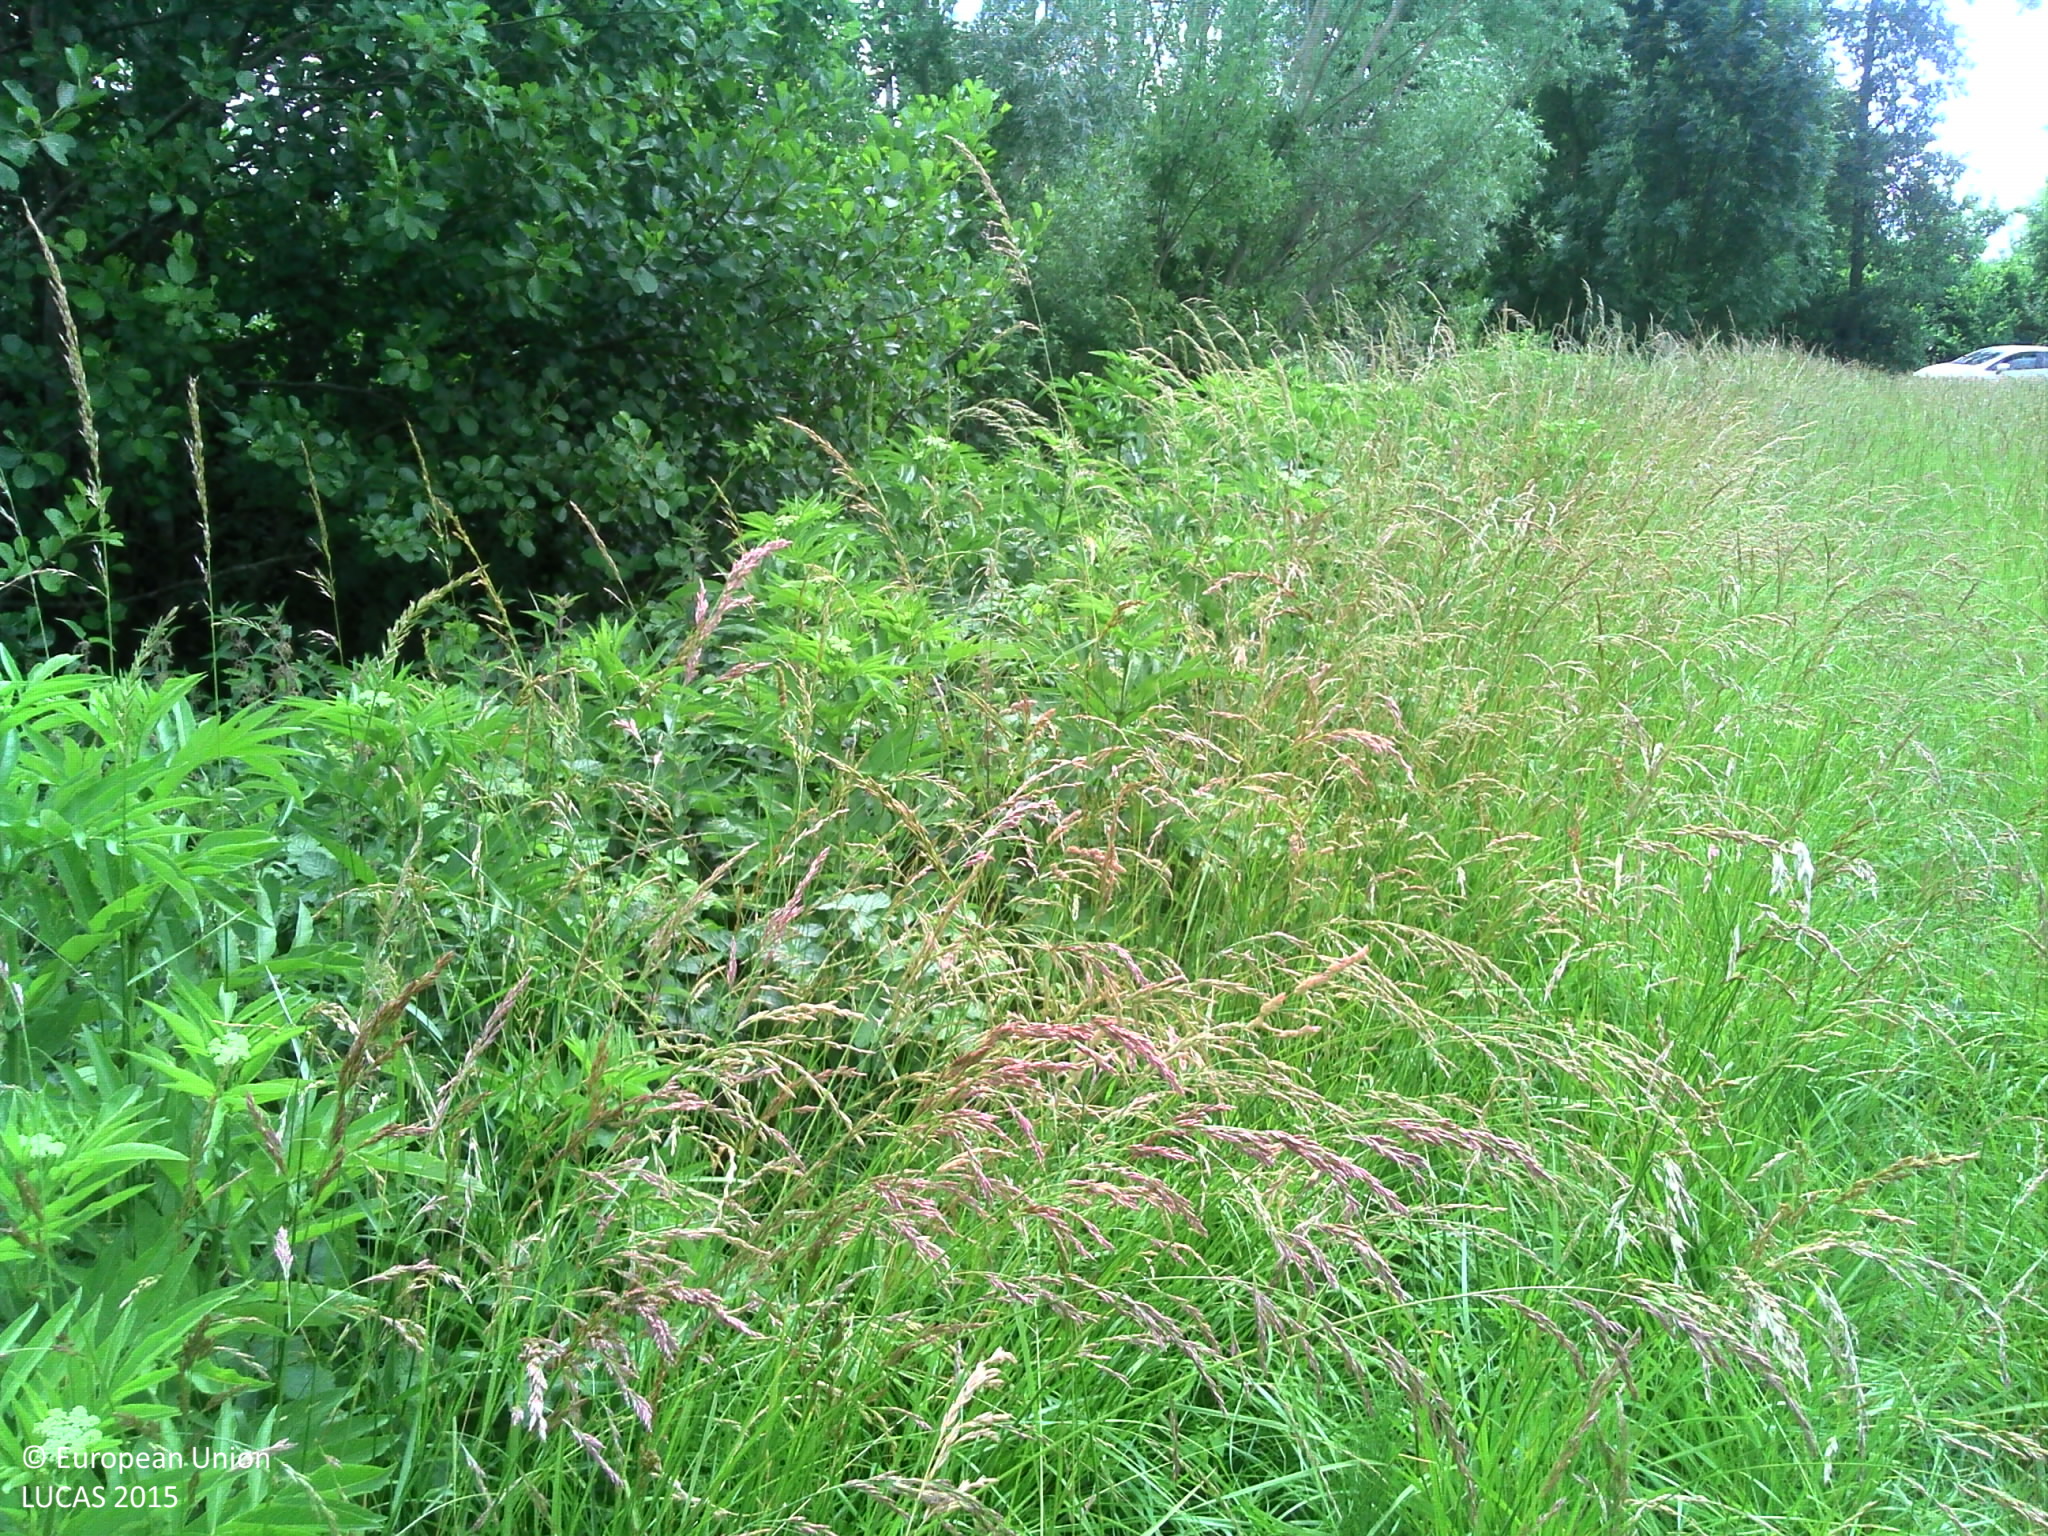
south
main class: Grassland
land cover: Grassland without tree/shrub cover
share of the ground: > 75 %
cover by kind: herbaceous plants 100 %
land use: Agriculture (excluding fallow land and kitchen gardens)
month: June
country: FR
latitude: 49.3786
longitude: 3.6991
